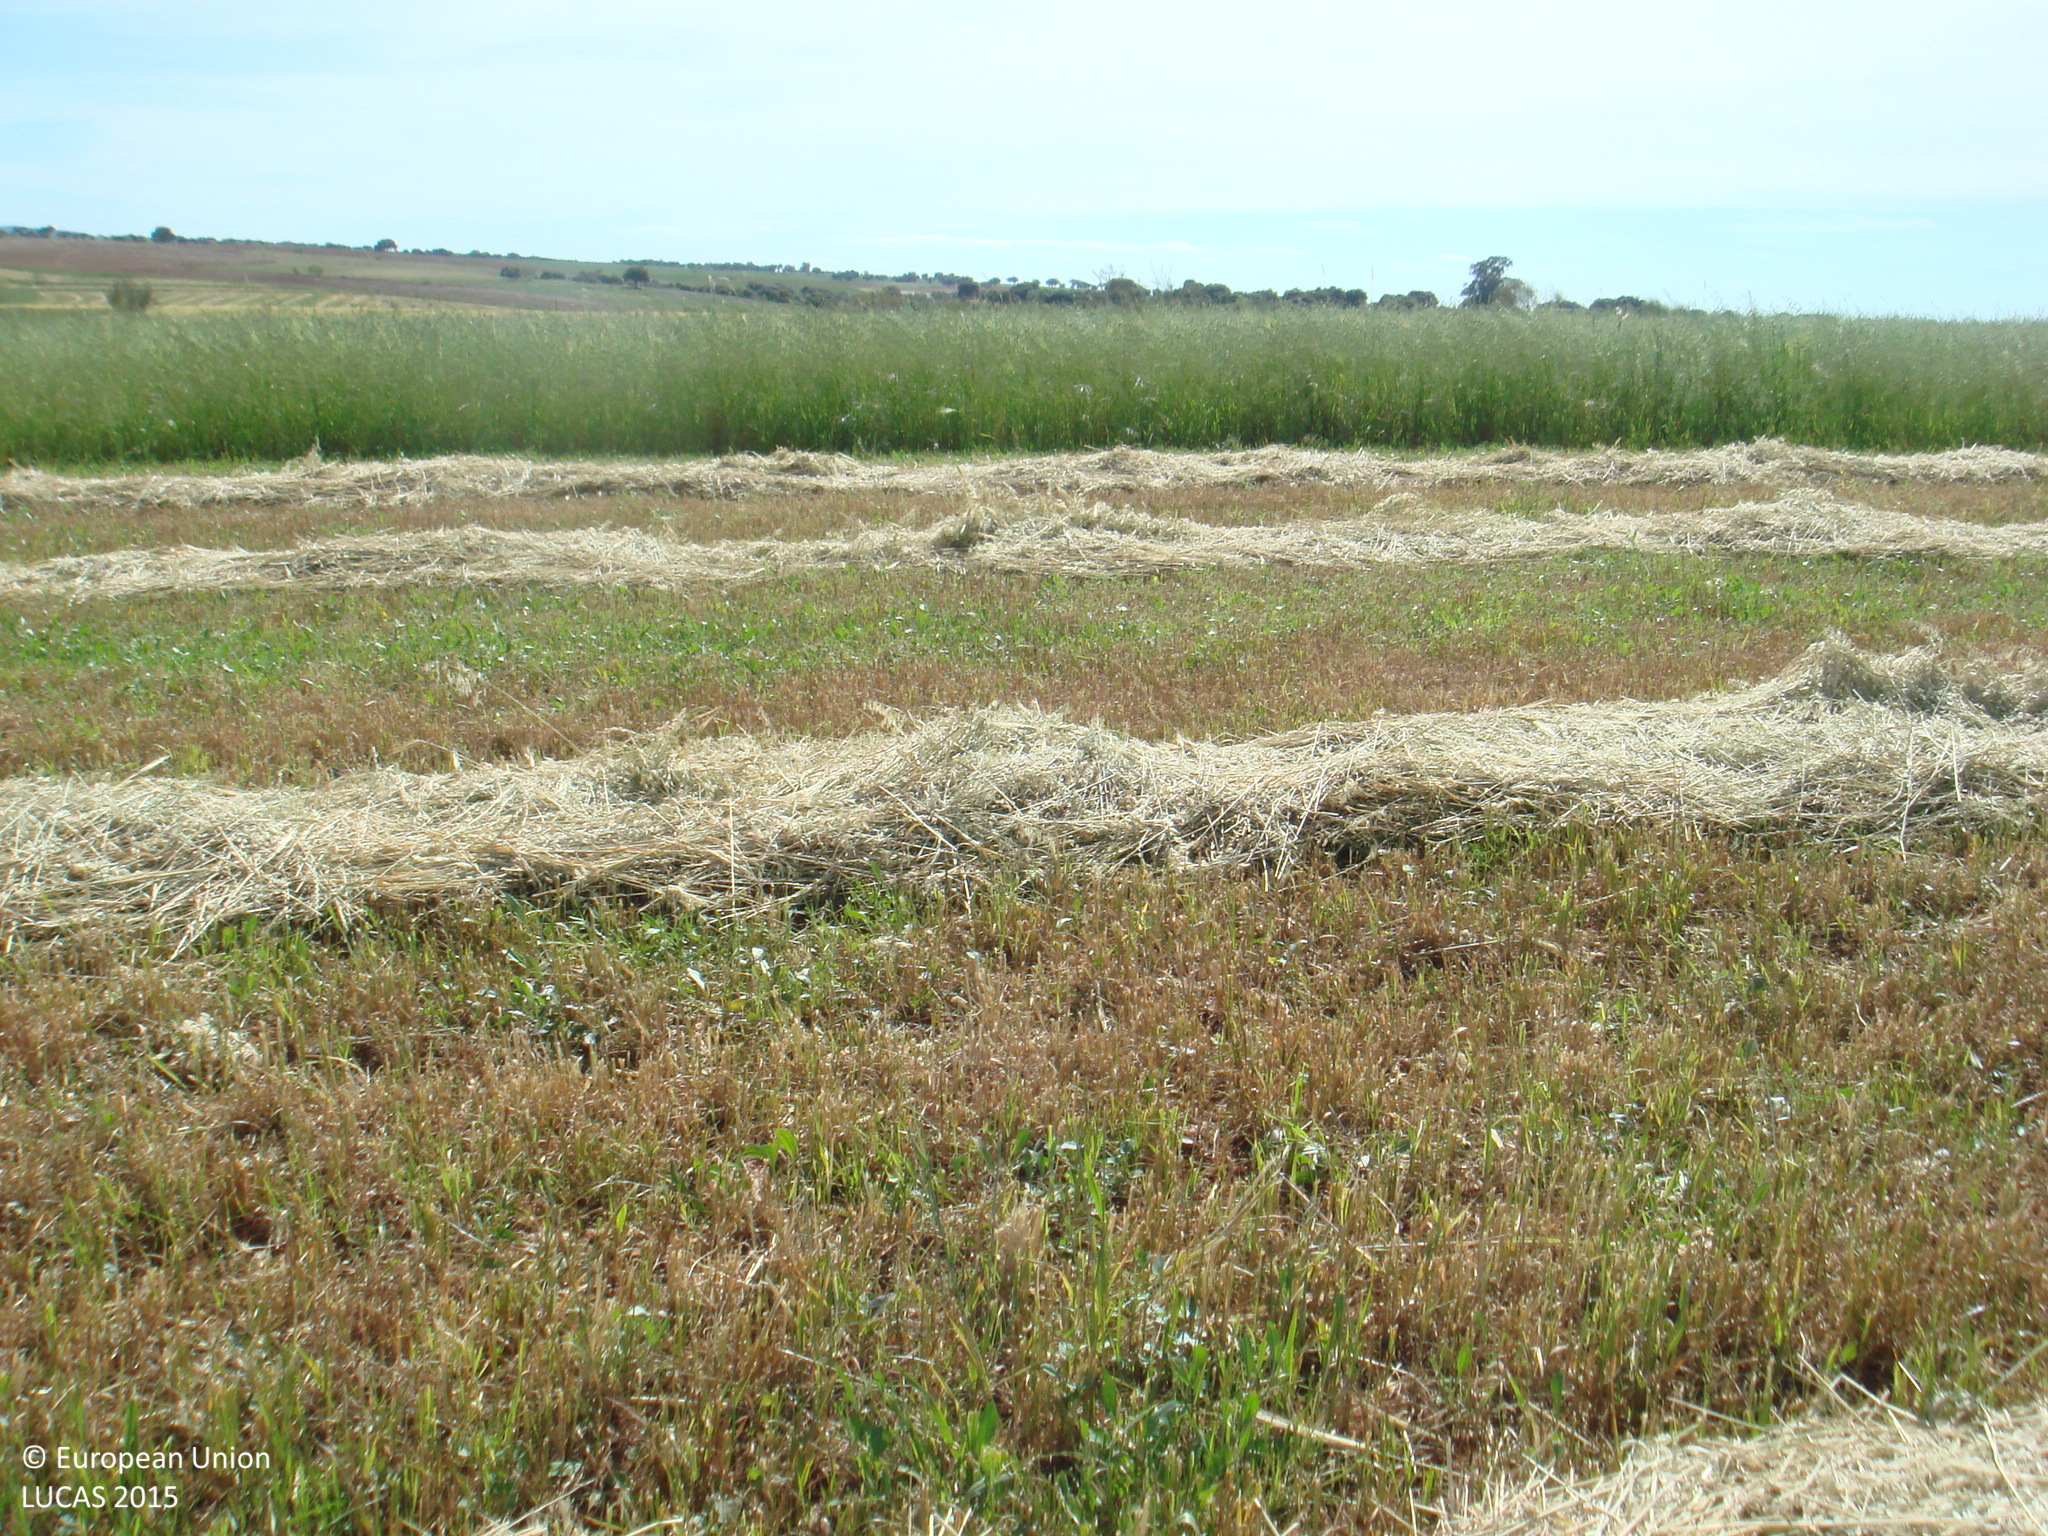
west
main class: Grassland
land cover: Grassland without tree/shrub cover
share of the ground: > 75 %
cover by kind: consolidated bare surface 80 %, herbaceous plants 20 %
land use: Agriculture (excluding fallow land and kitchen gardens)
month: April
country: ES
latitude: 38.4449
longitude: -5.1182
